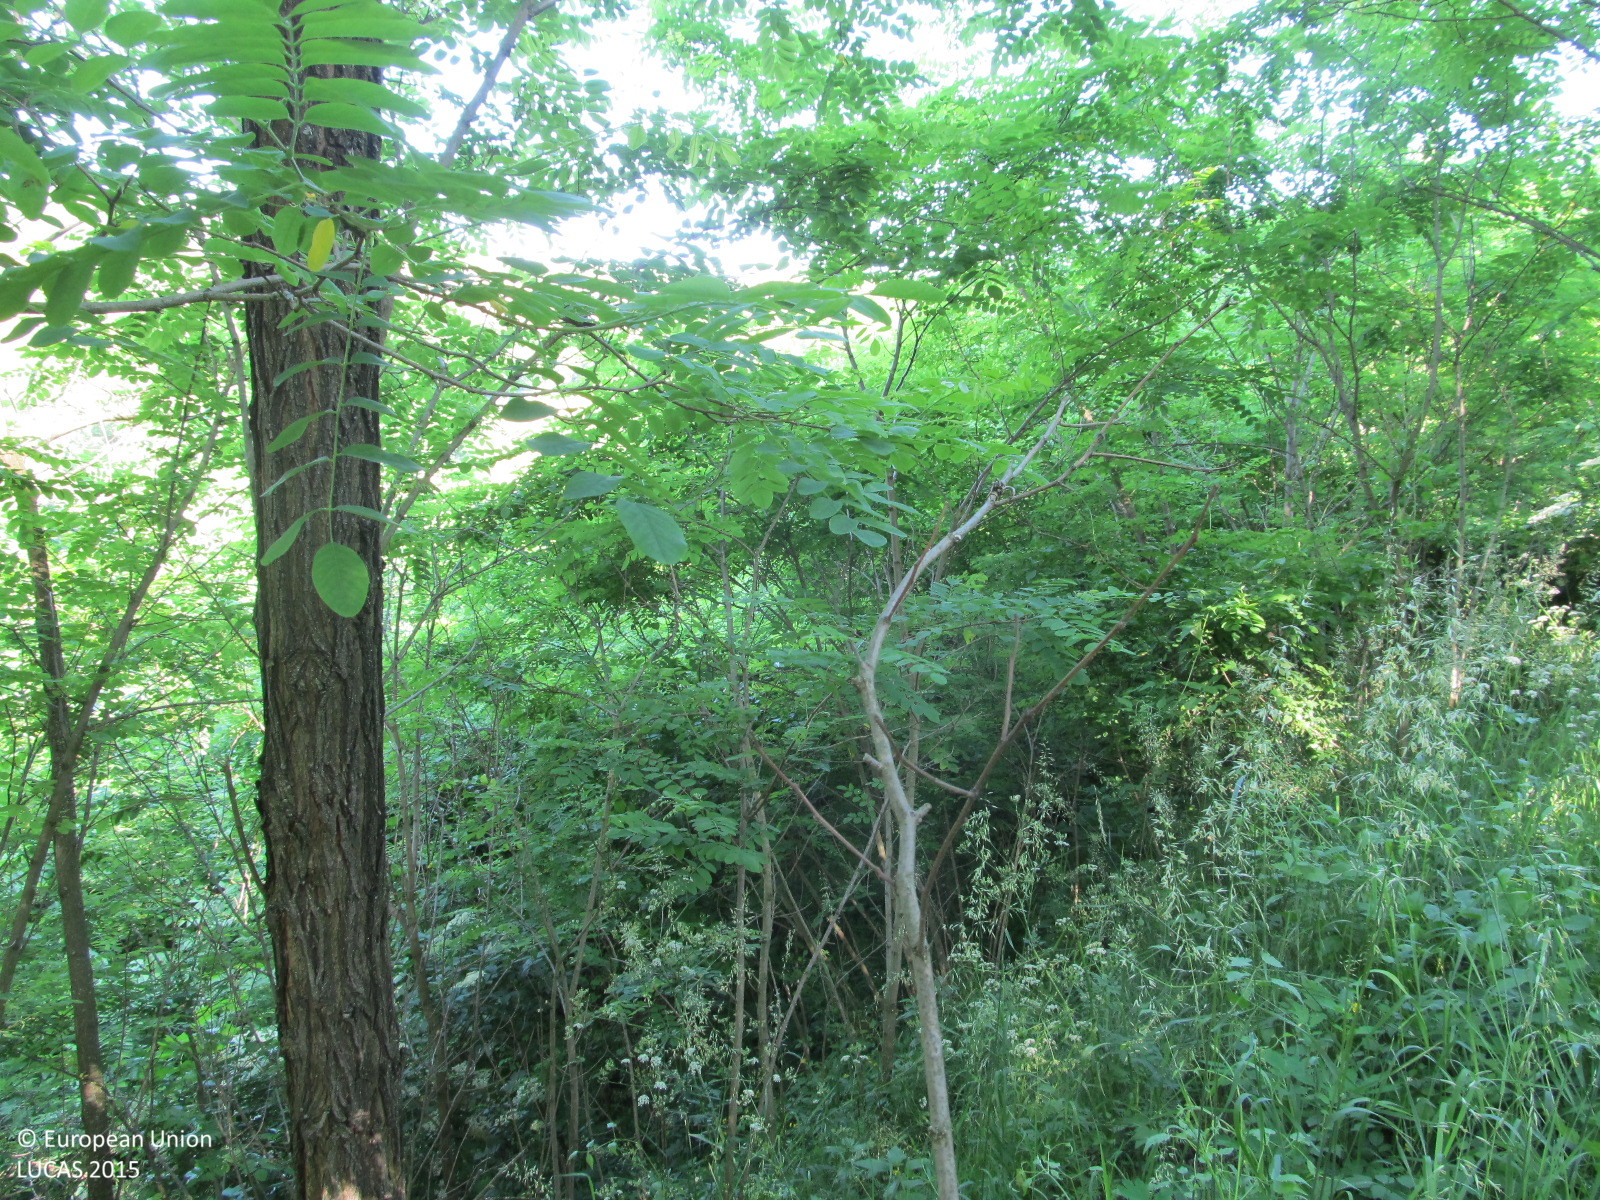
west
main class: Woodland
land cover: Broadleaved woodland
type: mesophytic deciduous forest
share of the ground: > 75 %
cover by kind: broadleaved forest trees 75 %, shrubs 15 %, herbaceous plants 10 %
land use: Semi-natural and natural areas not in use
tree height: > 5 m
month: June
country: AT
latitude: 48.4976
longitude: 15.9179
